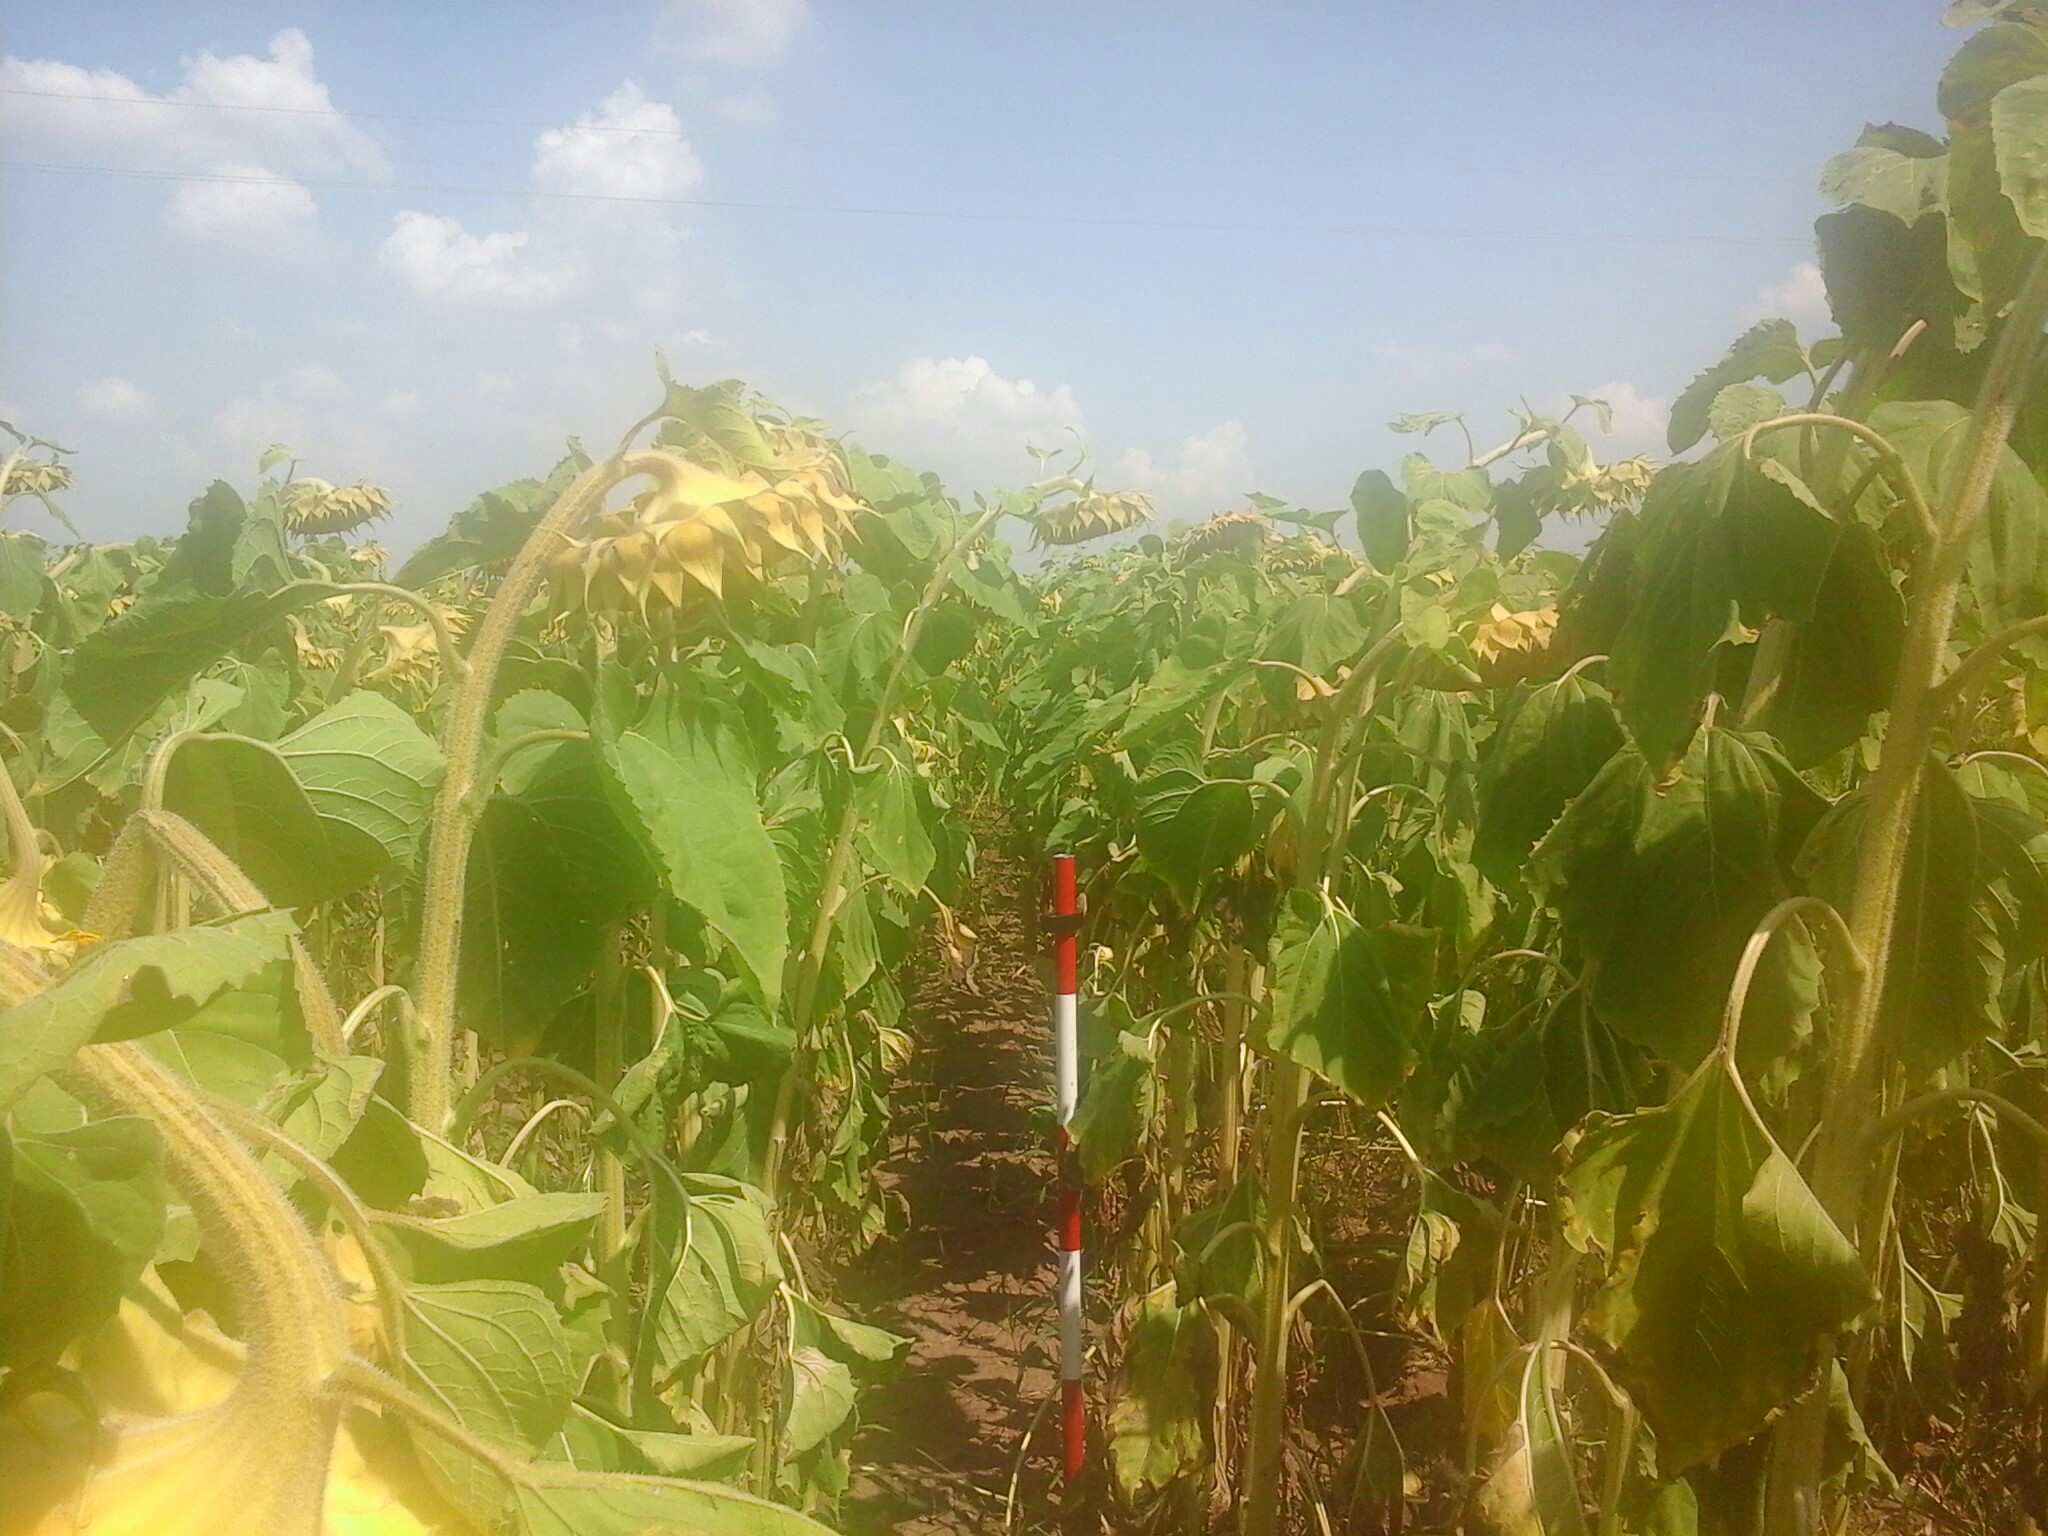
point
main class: Cropland
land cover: Sunflower
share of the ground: > 75 %
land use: Agriculture (excluding fallow land and kitchen gardens)
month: August
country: HU
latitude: 47.5907
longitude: 17.9764
